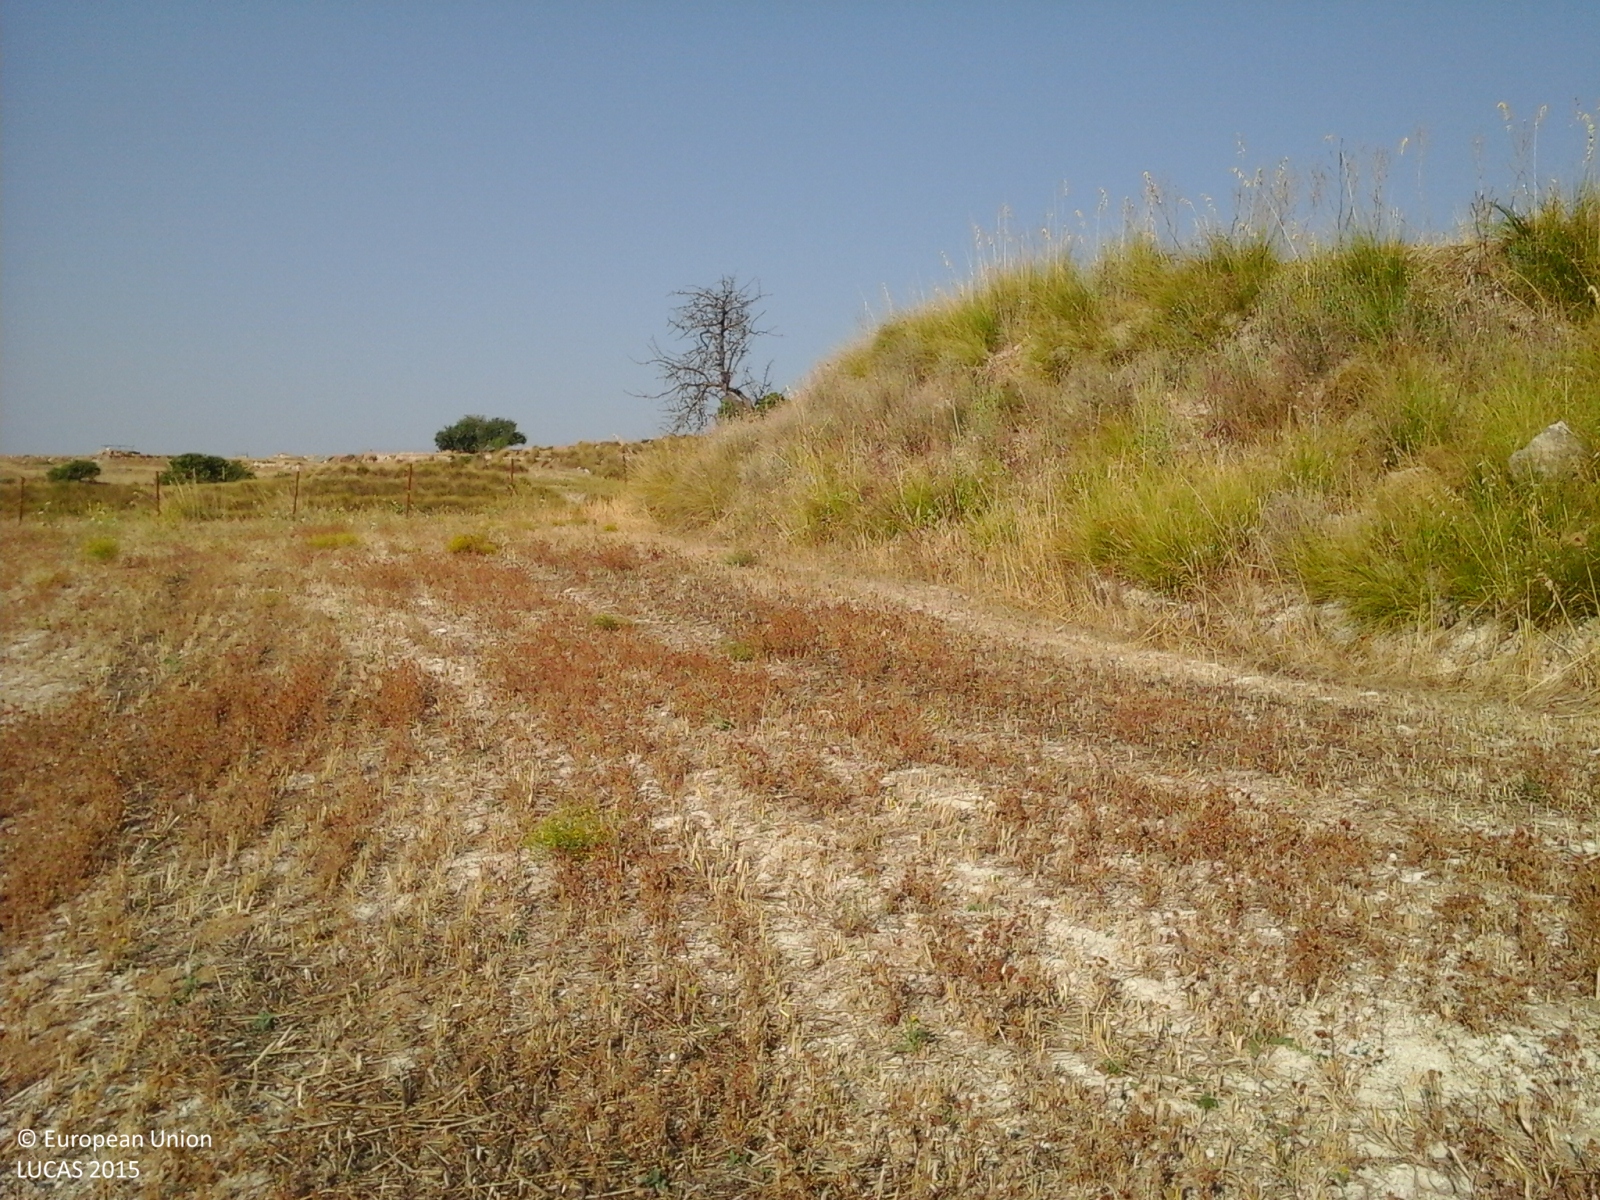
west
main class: Cropland
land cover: Mixed cereals for fodder
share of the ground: > 75 %
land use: Agriculture (excluding fallow land and kitchen gardens)
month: July
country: IT
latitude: 37.0427
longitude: 14.8308
